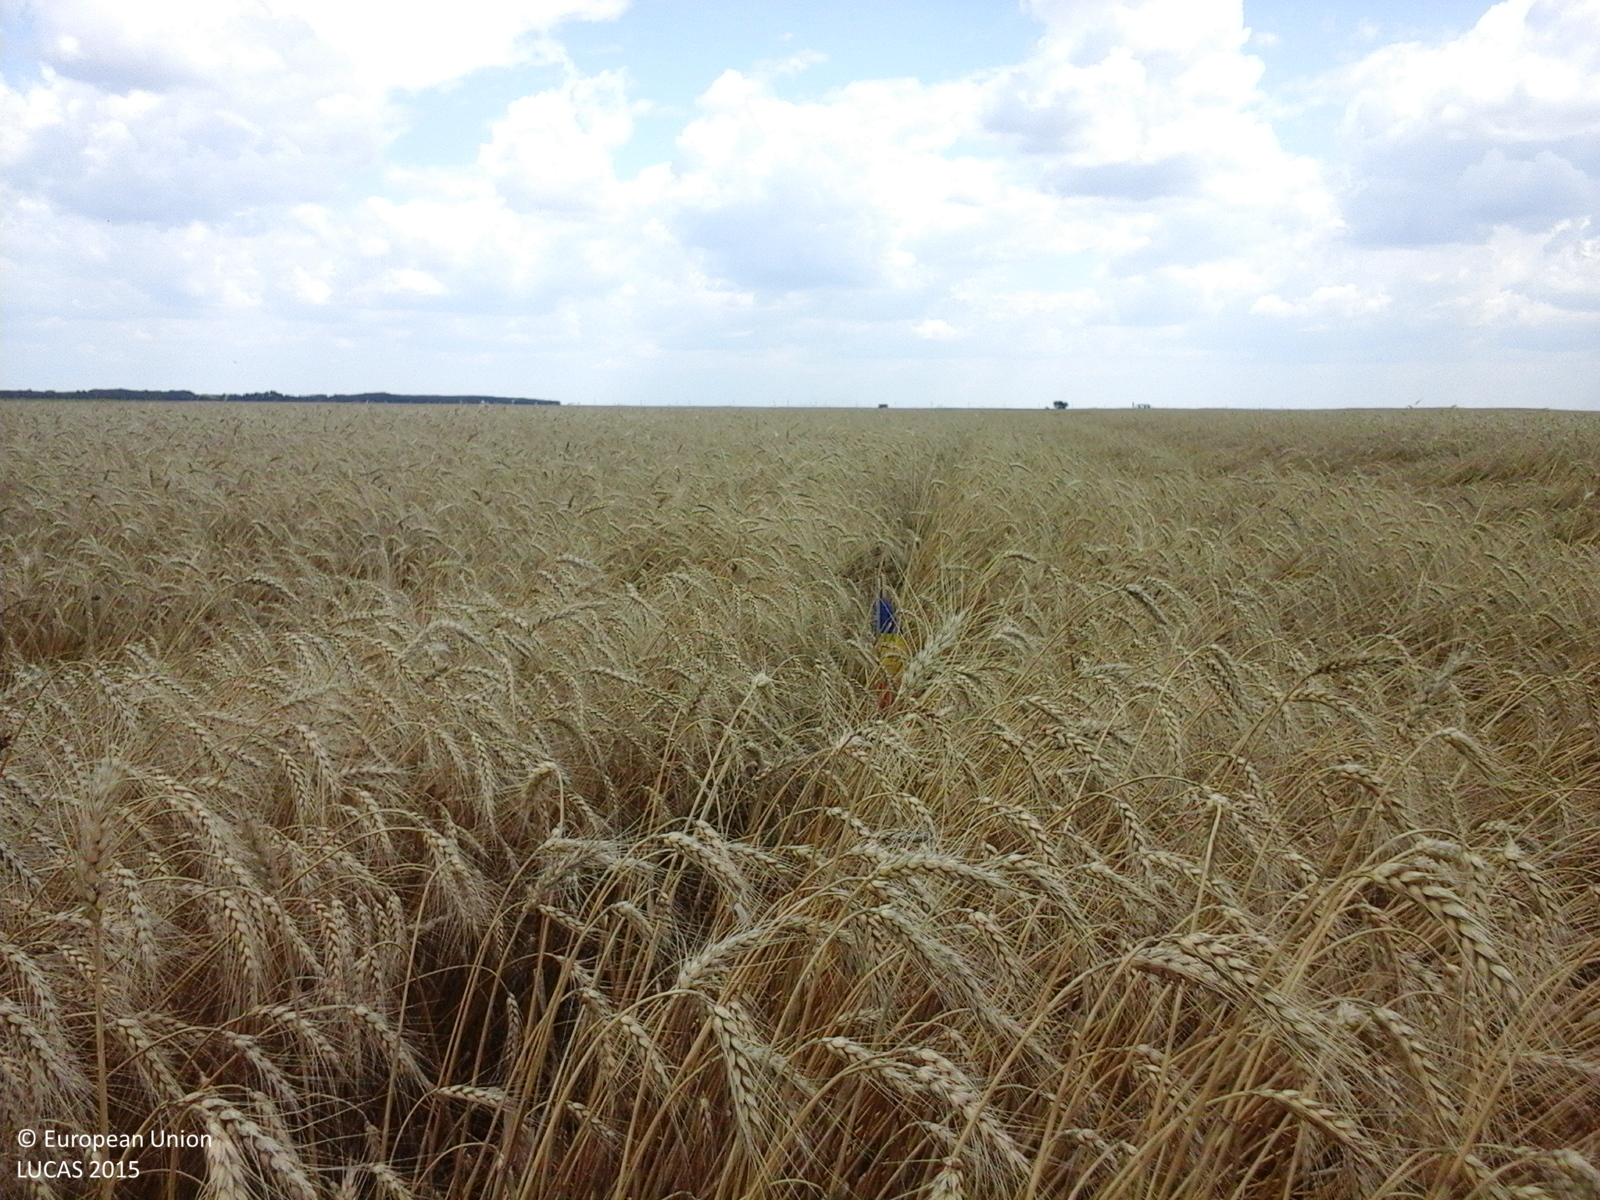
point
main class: Cropland
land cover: Common wheat
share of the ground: > 75 %
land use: Agriculture (excluding fallow land and kitchen gardens)
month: July
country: RO
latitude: 44.0072
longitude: 24.7259
